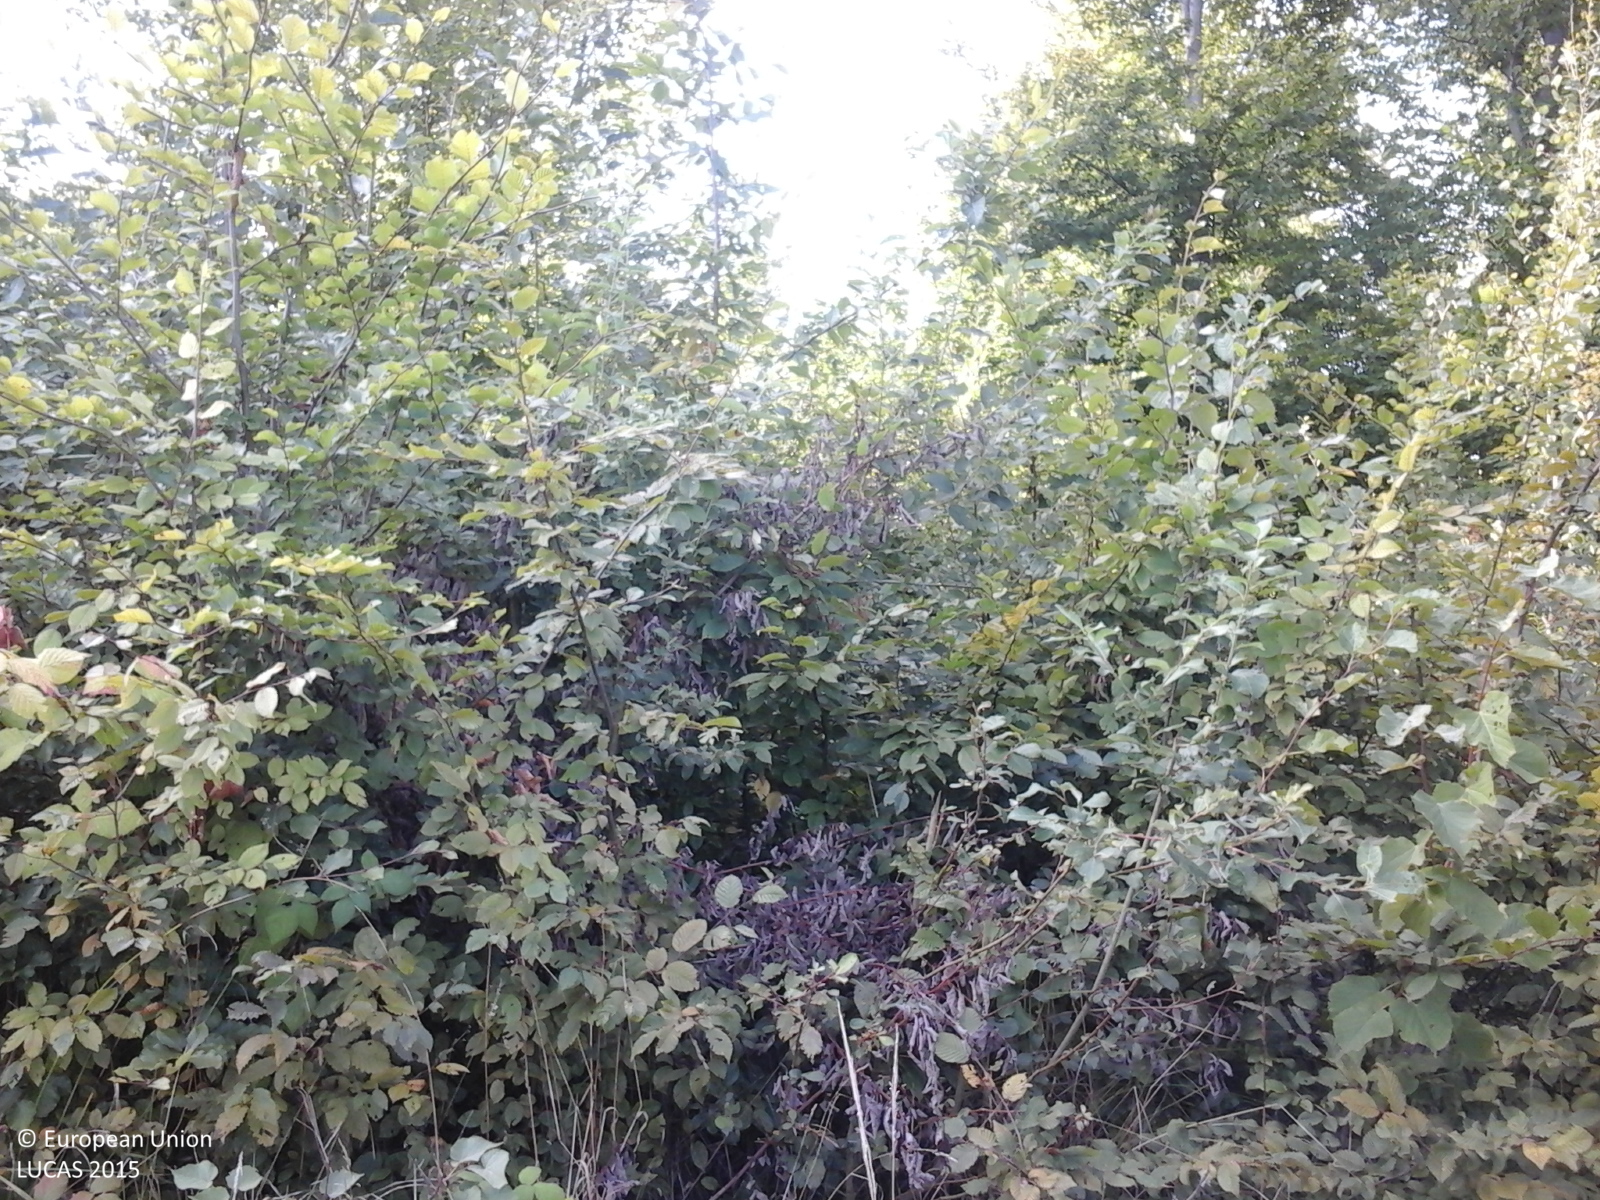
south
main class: Woodland
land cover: Broadleaved woodland
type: acidophilous oak and oak-birch forest
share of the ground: > 75 %
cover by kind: broadleaved forest trees 95 %, herbaceous plants 5 %
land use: Forestry
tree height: < 5 m
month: September
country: RO
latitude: 45.4761
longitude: 22.1287
